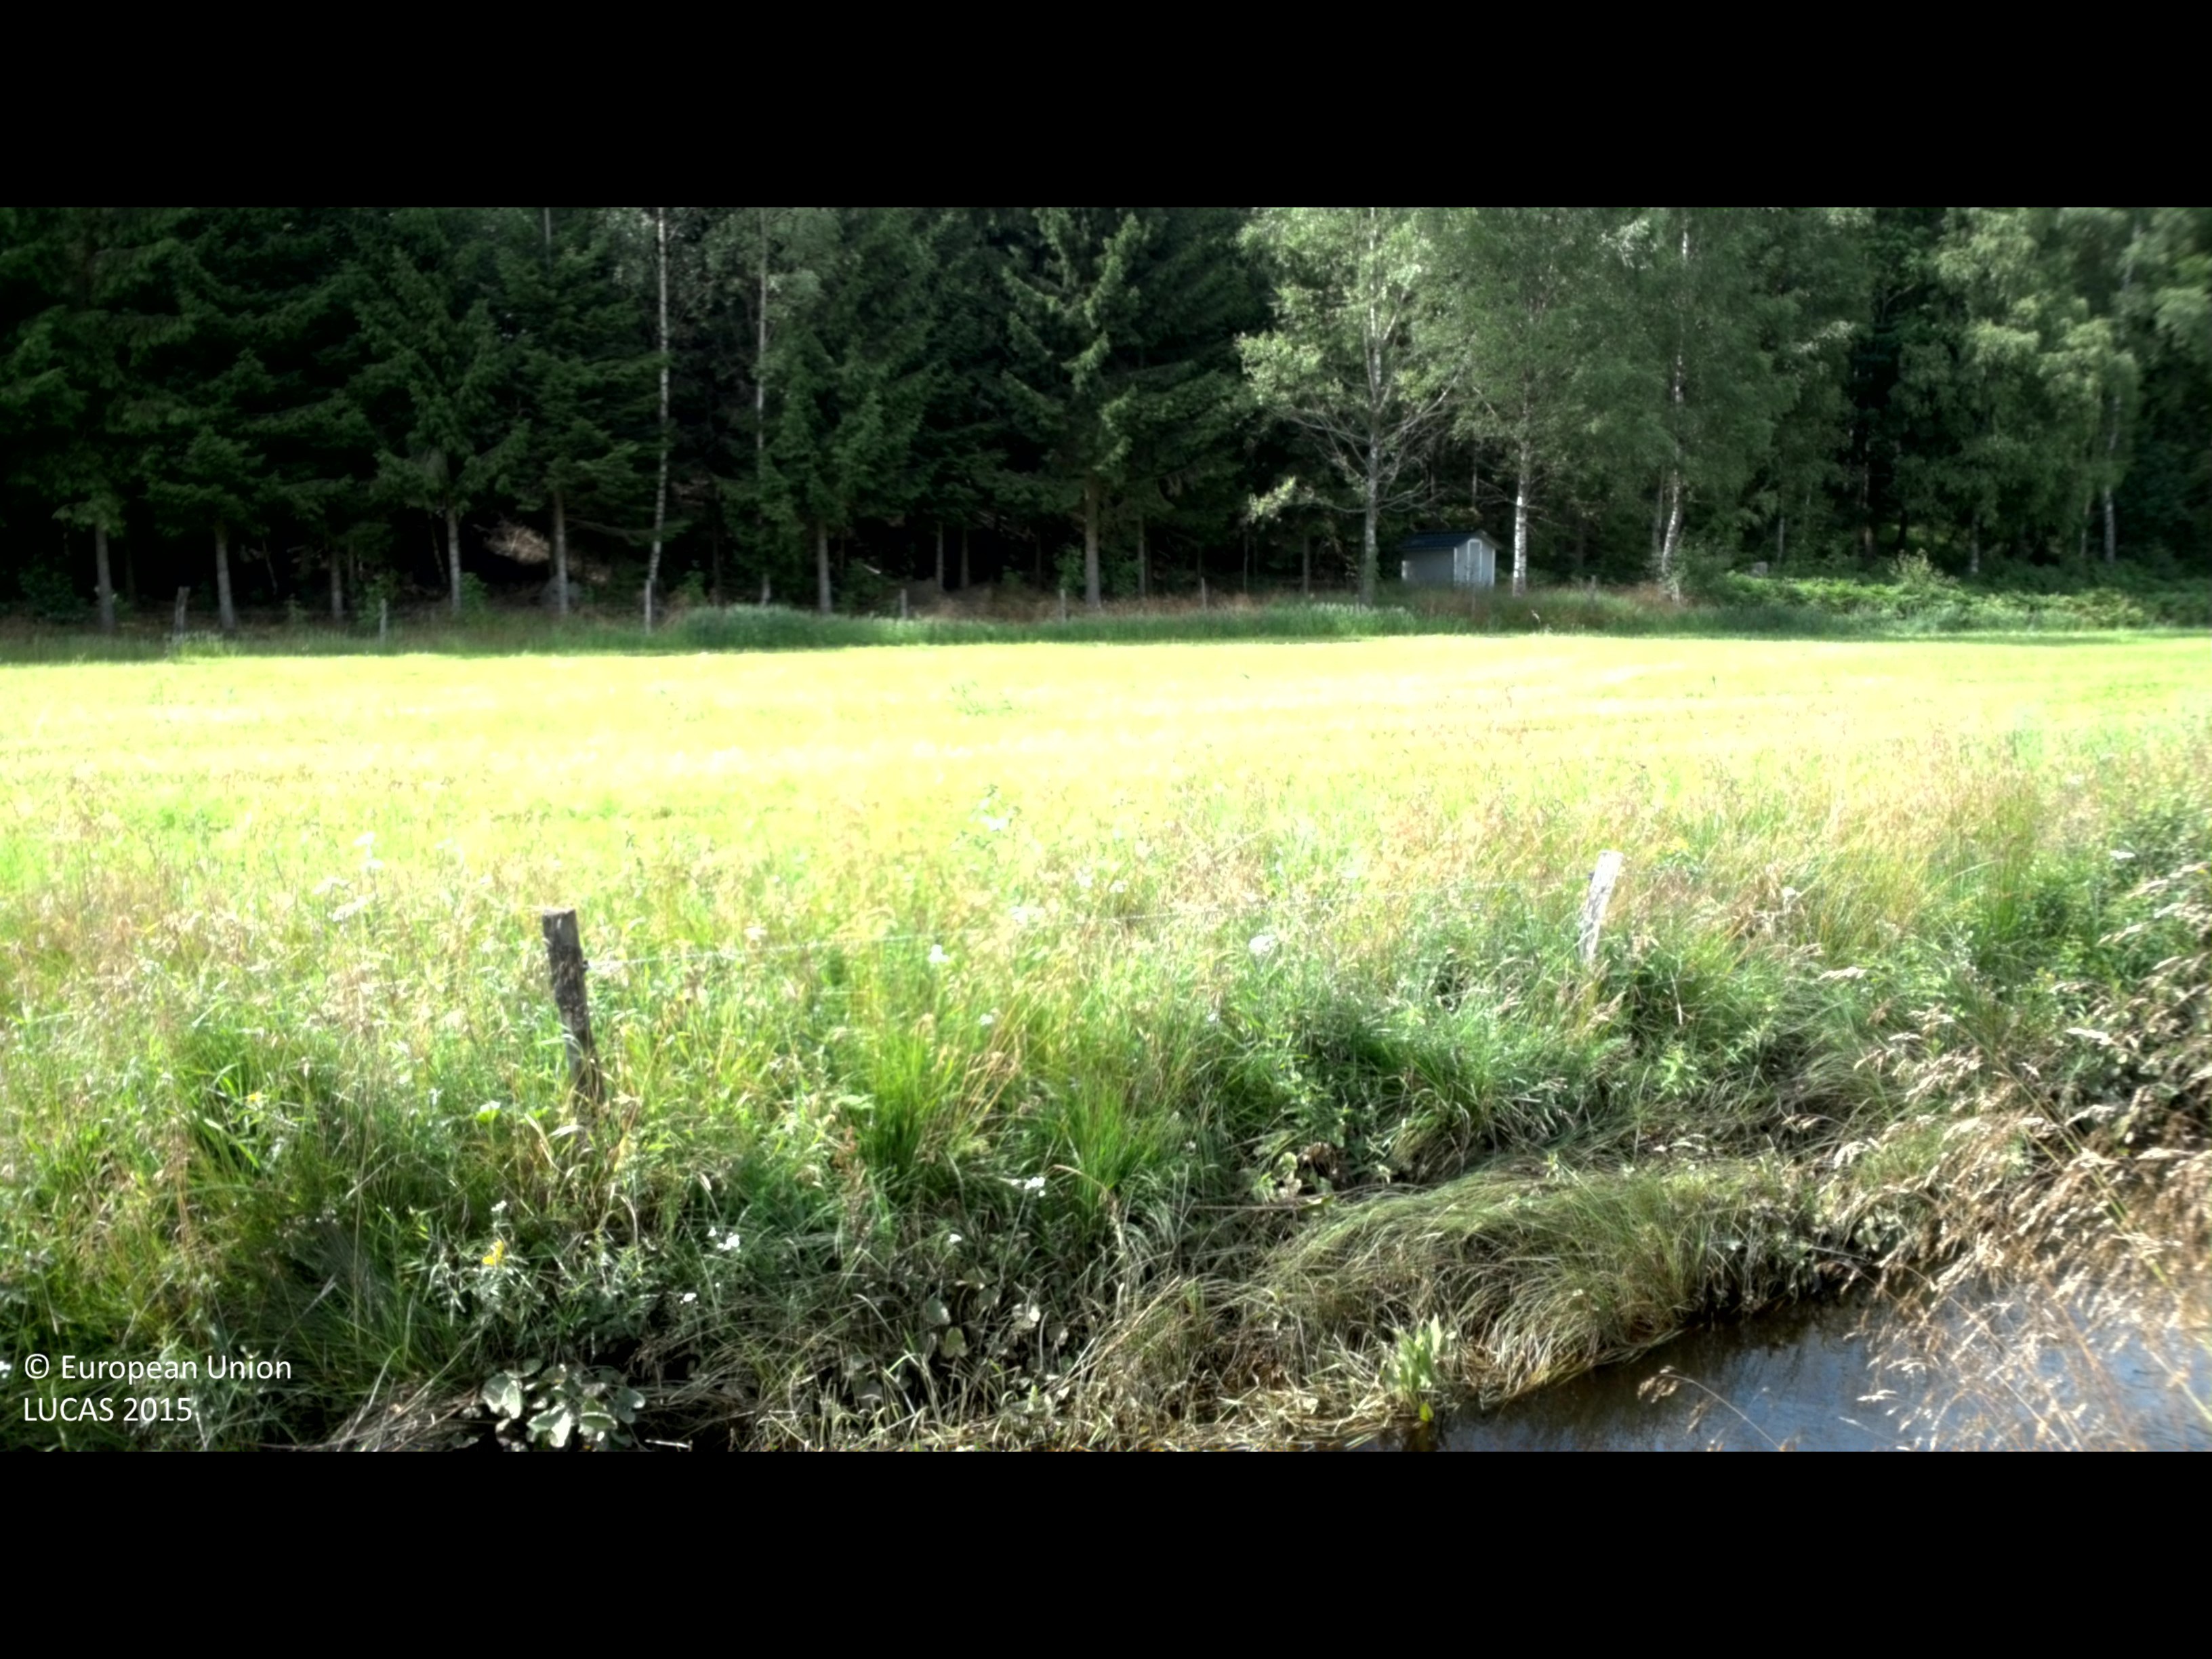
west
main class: Cropland
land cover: Temporary grasslands
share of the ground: > 75 %
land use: Agriculture (excluding fallow land and kitchen gardens)
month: August
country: SE
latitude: 56.3862
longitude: 14.2896
